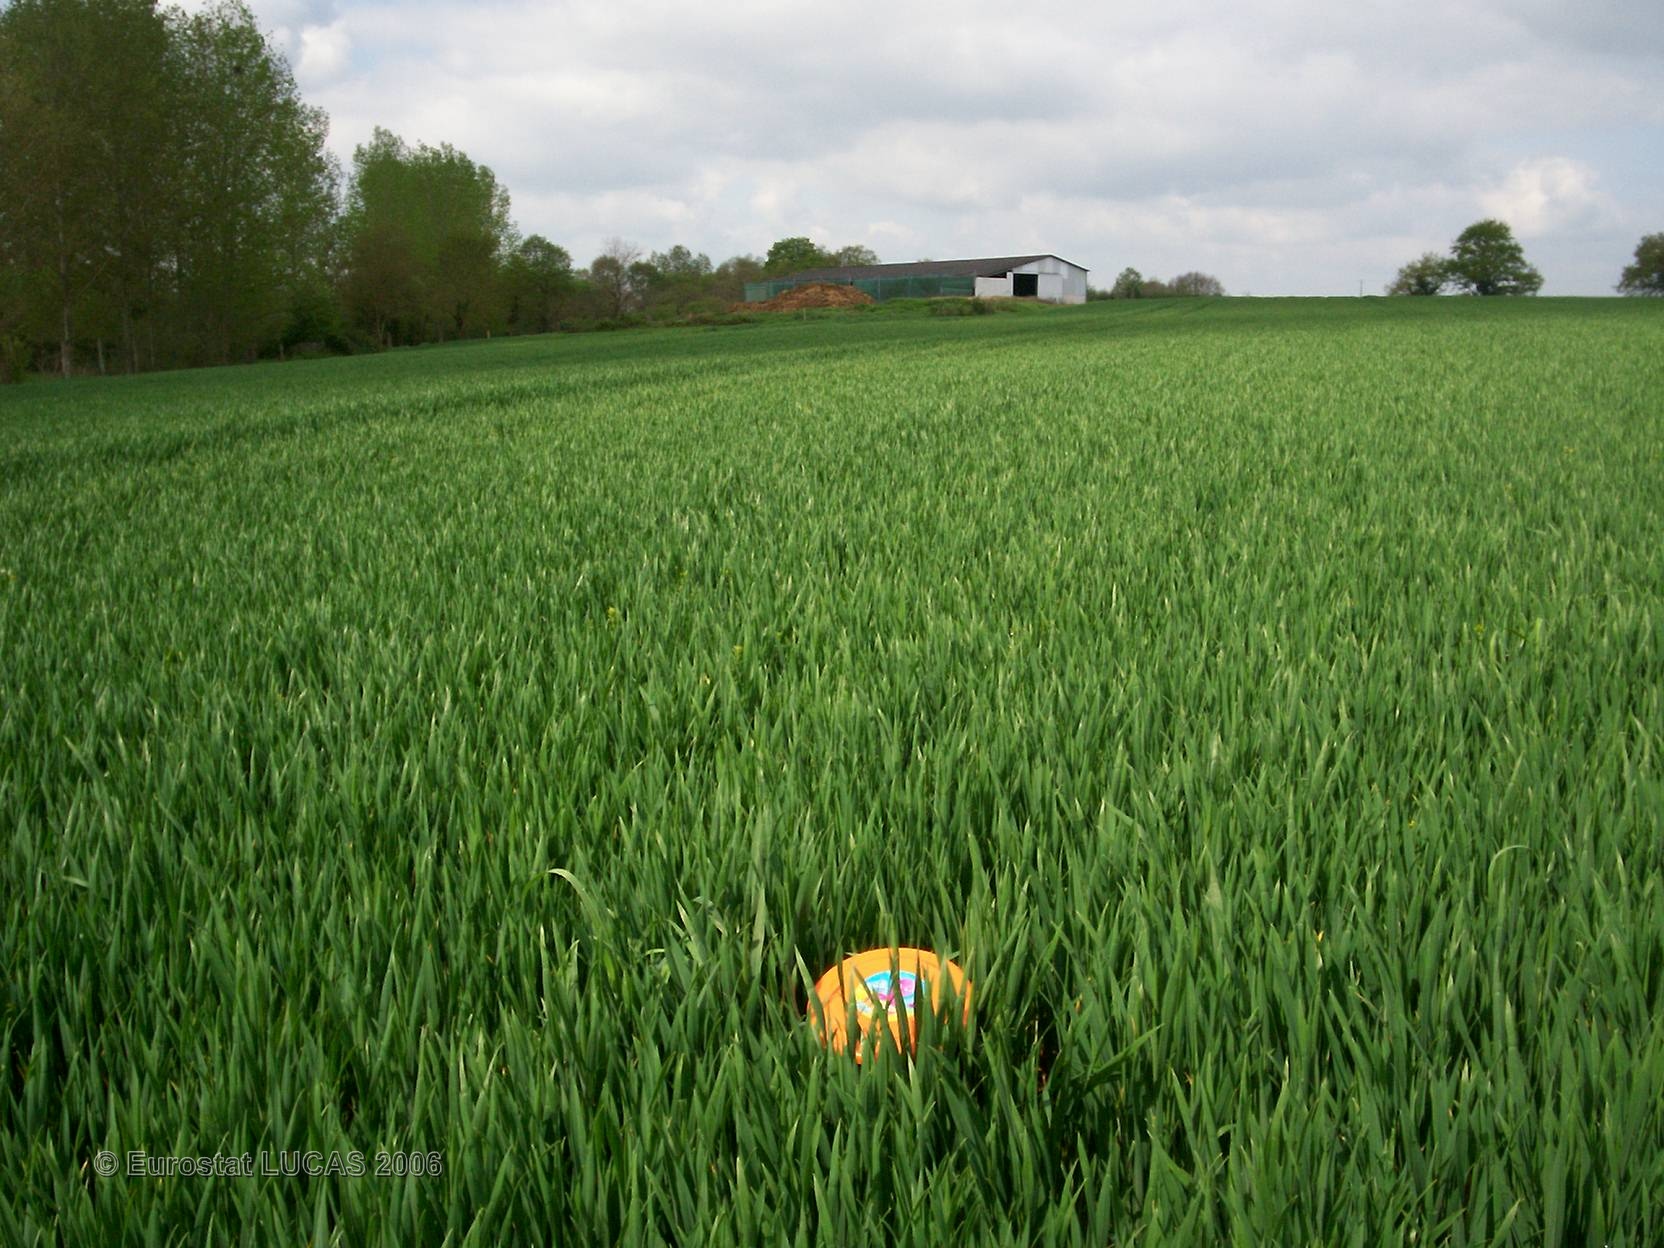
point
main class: Cropland
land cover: Common wheat
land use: Agriculture (excluding fallow land and kitchen gardens)
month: April
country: FR
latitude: 47.0472
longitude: -0.3337
